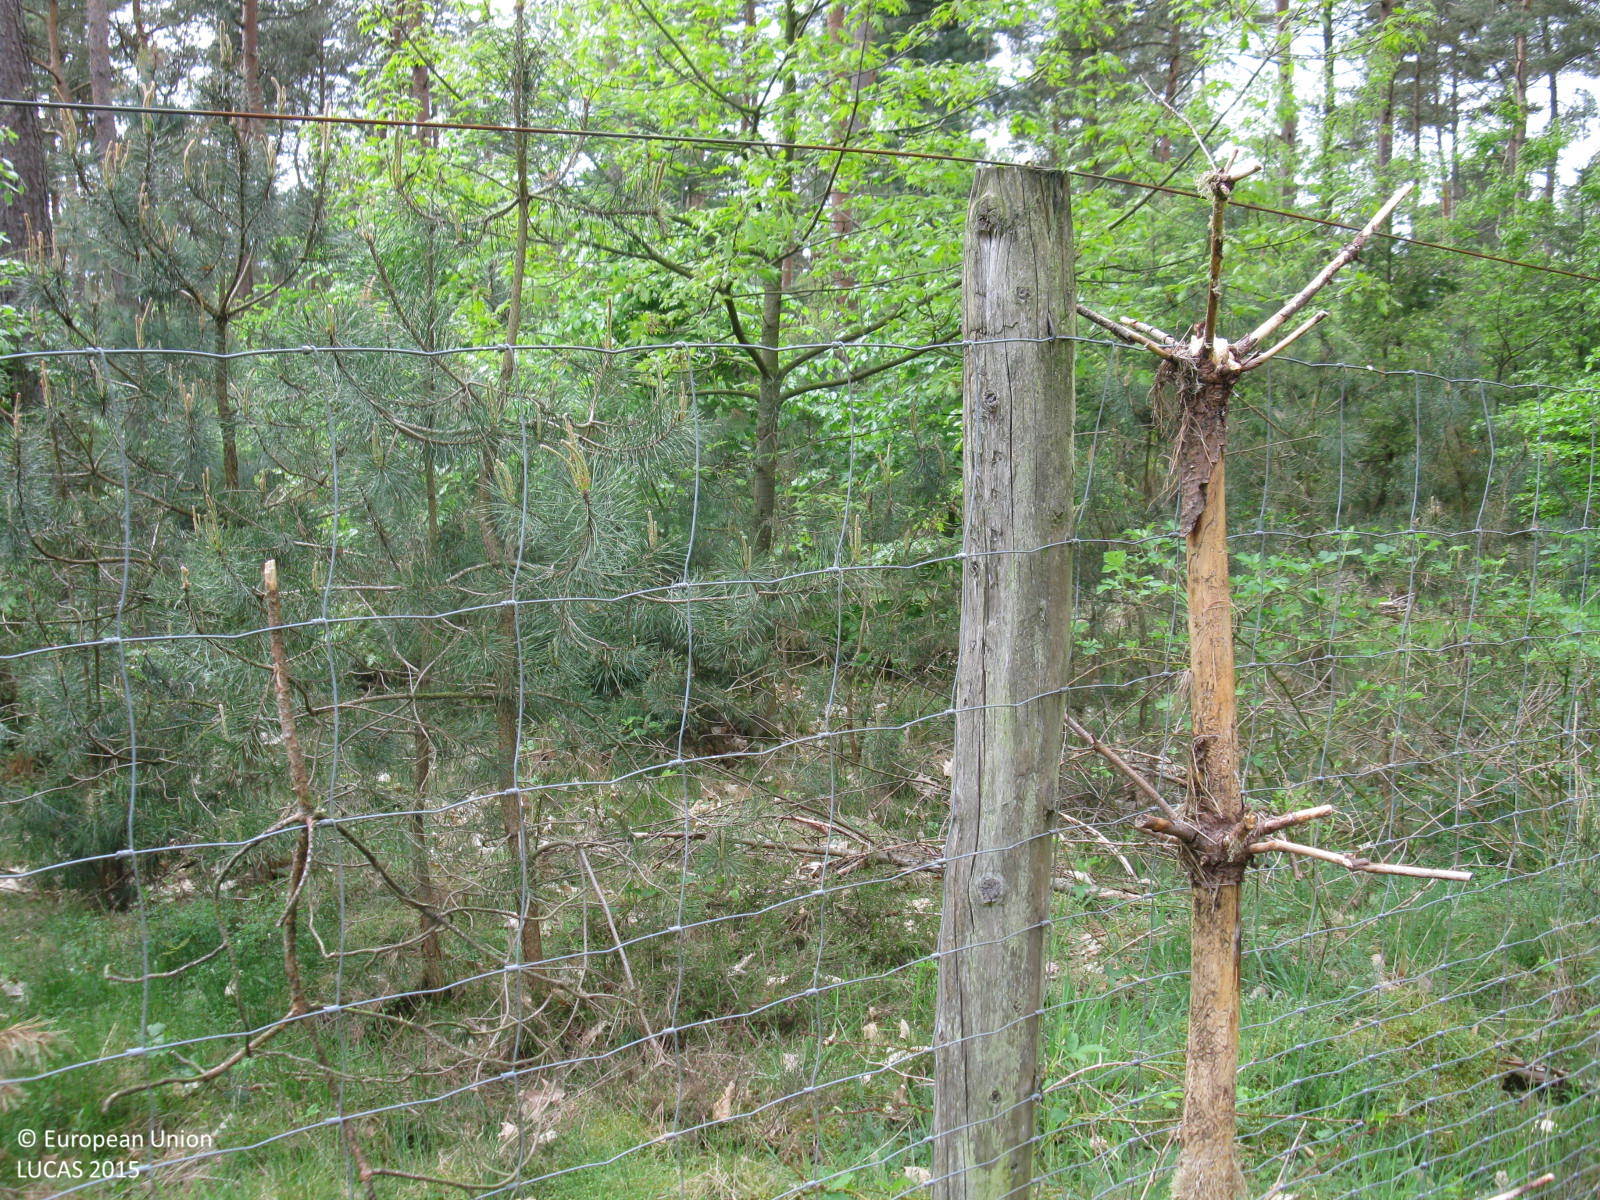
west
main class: Woodland
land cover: Pine dominated coniferous woodland
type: hemiboreal forest and nemoral coniferous forest and mixed broadleaved-coniferous forest
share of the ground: 50 - 75 %
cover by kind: coniferous forest trees 70 %, broadleaved forest trees 10 %, shrubs 10 %, herbaceous plants 10 %
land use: Forestry
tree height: > 5 m
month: May
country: DE
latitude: 52.8333
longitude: 7.3435
